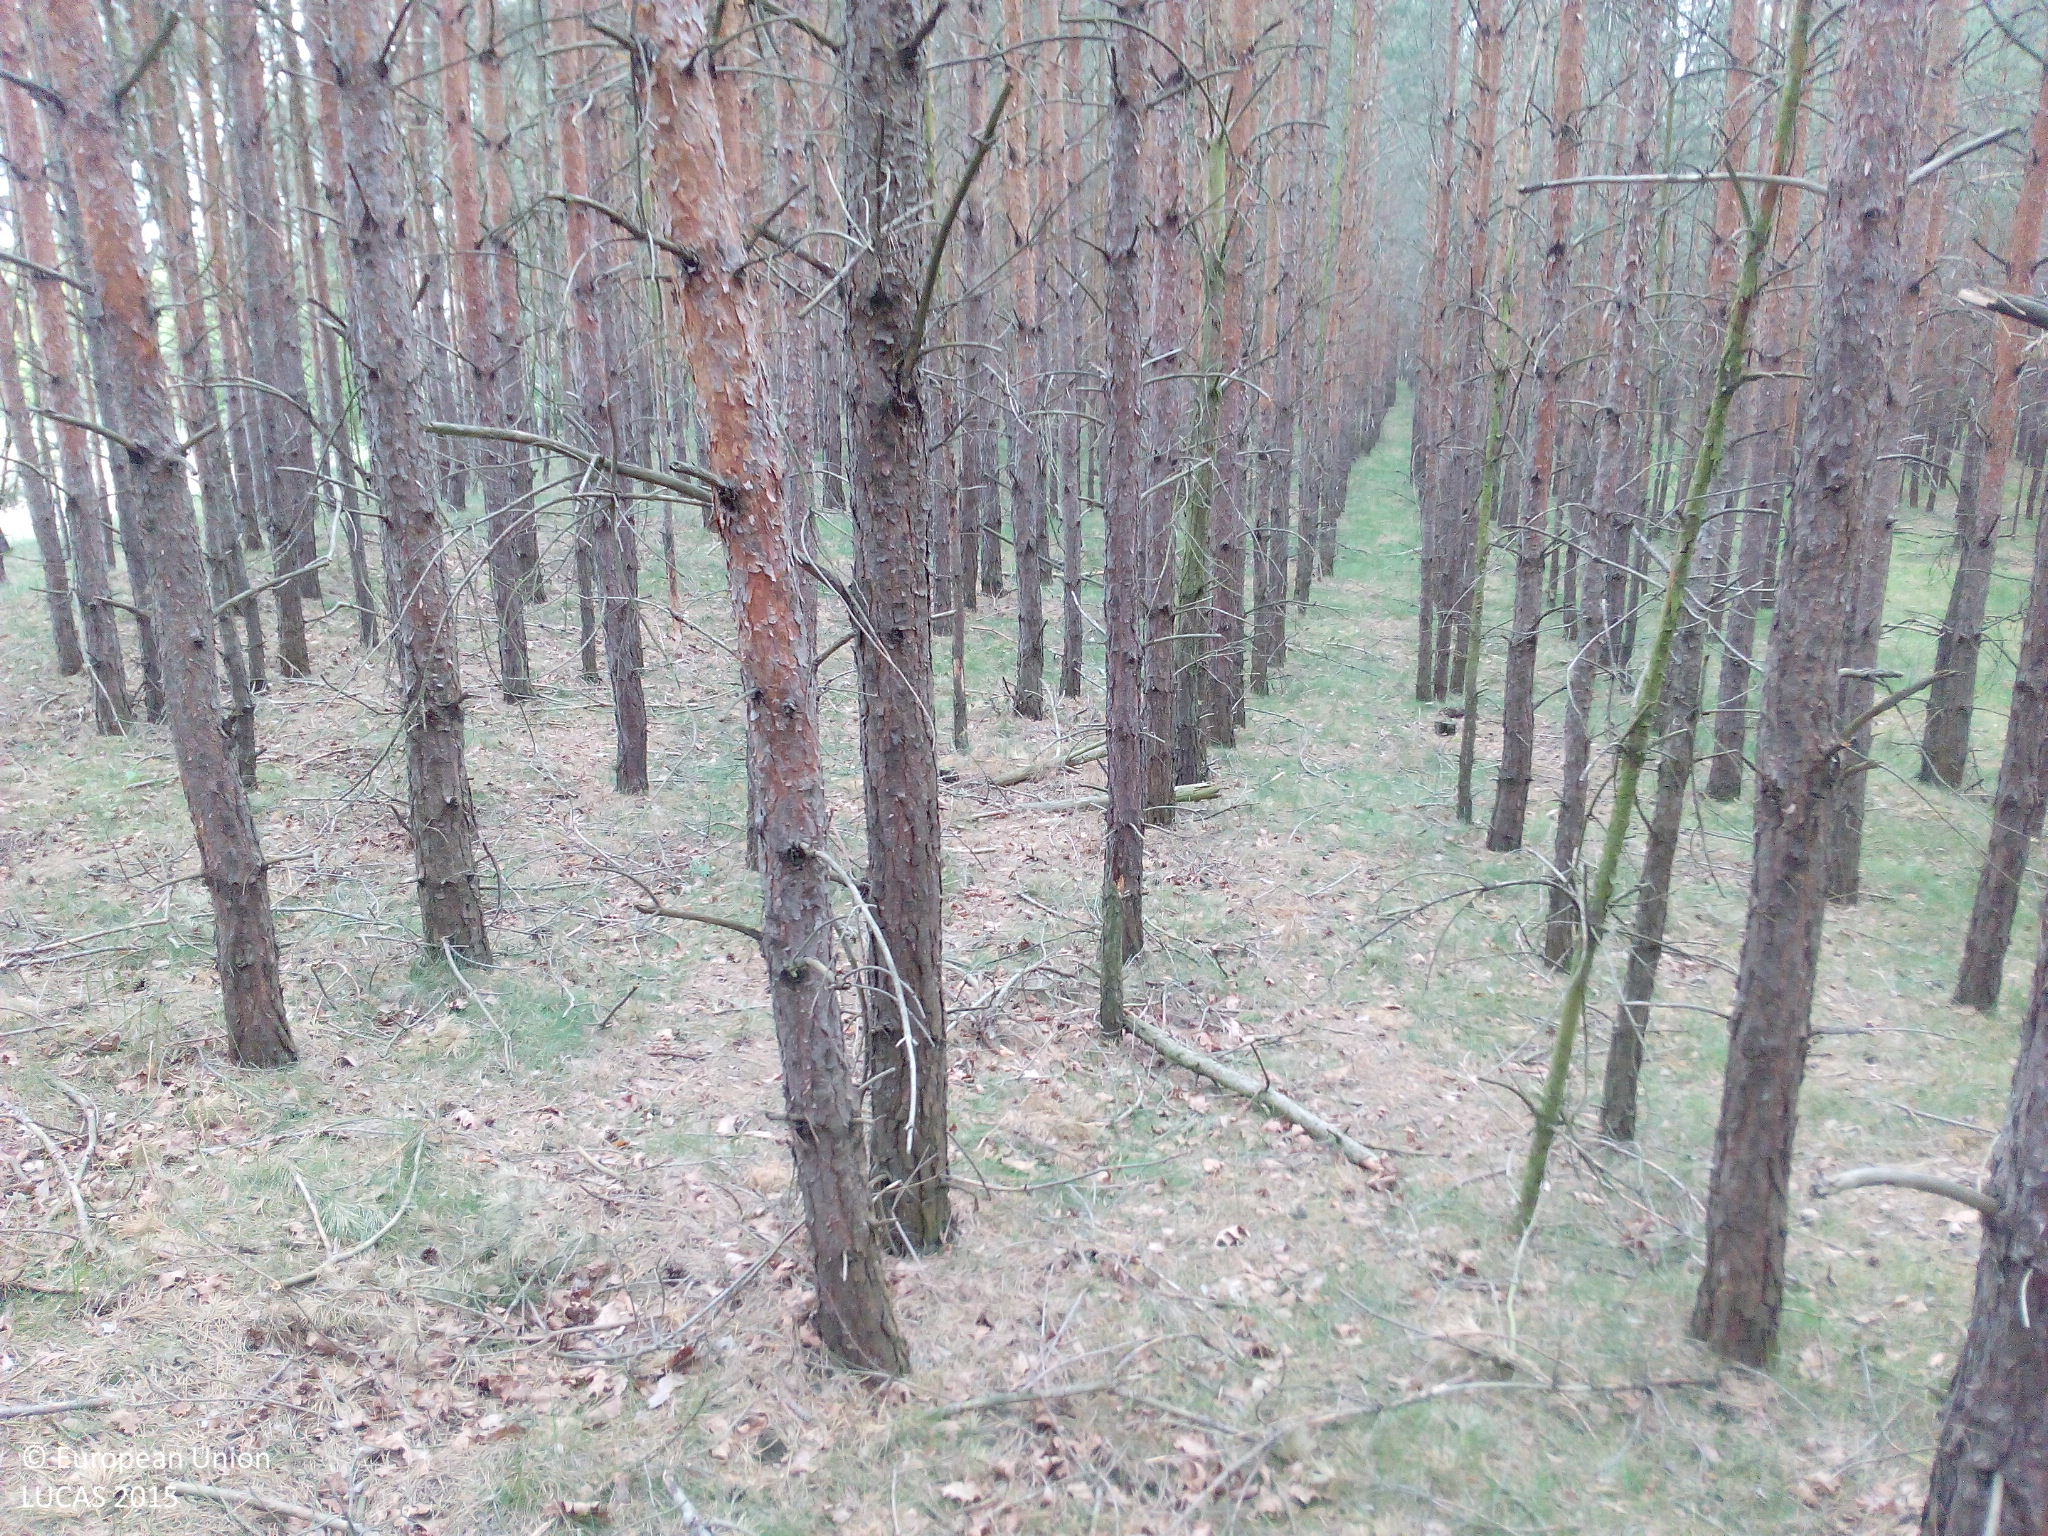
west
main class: Woodland
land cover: Pine dominated coniferous woodland
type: hemiboreal forest and nemoral coniferous forest and mixed broadleaved-coniferous forest
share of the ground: > 75 %
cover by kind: coniferous forest trees 80 %, herbaceous plants 10 %, unconsolidated bare surface 10 %
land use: Forestry
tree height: > 5 m
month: May
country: DE
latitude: 52.1919
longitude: 13.1451
